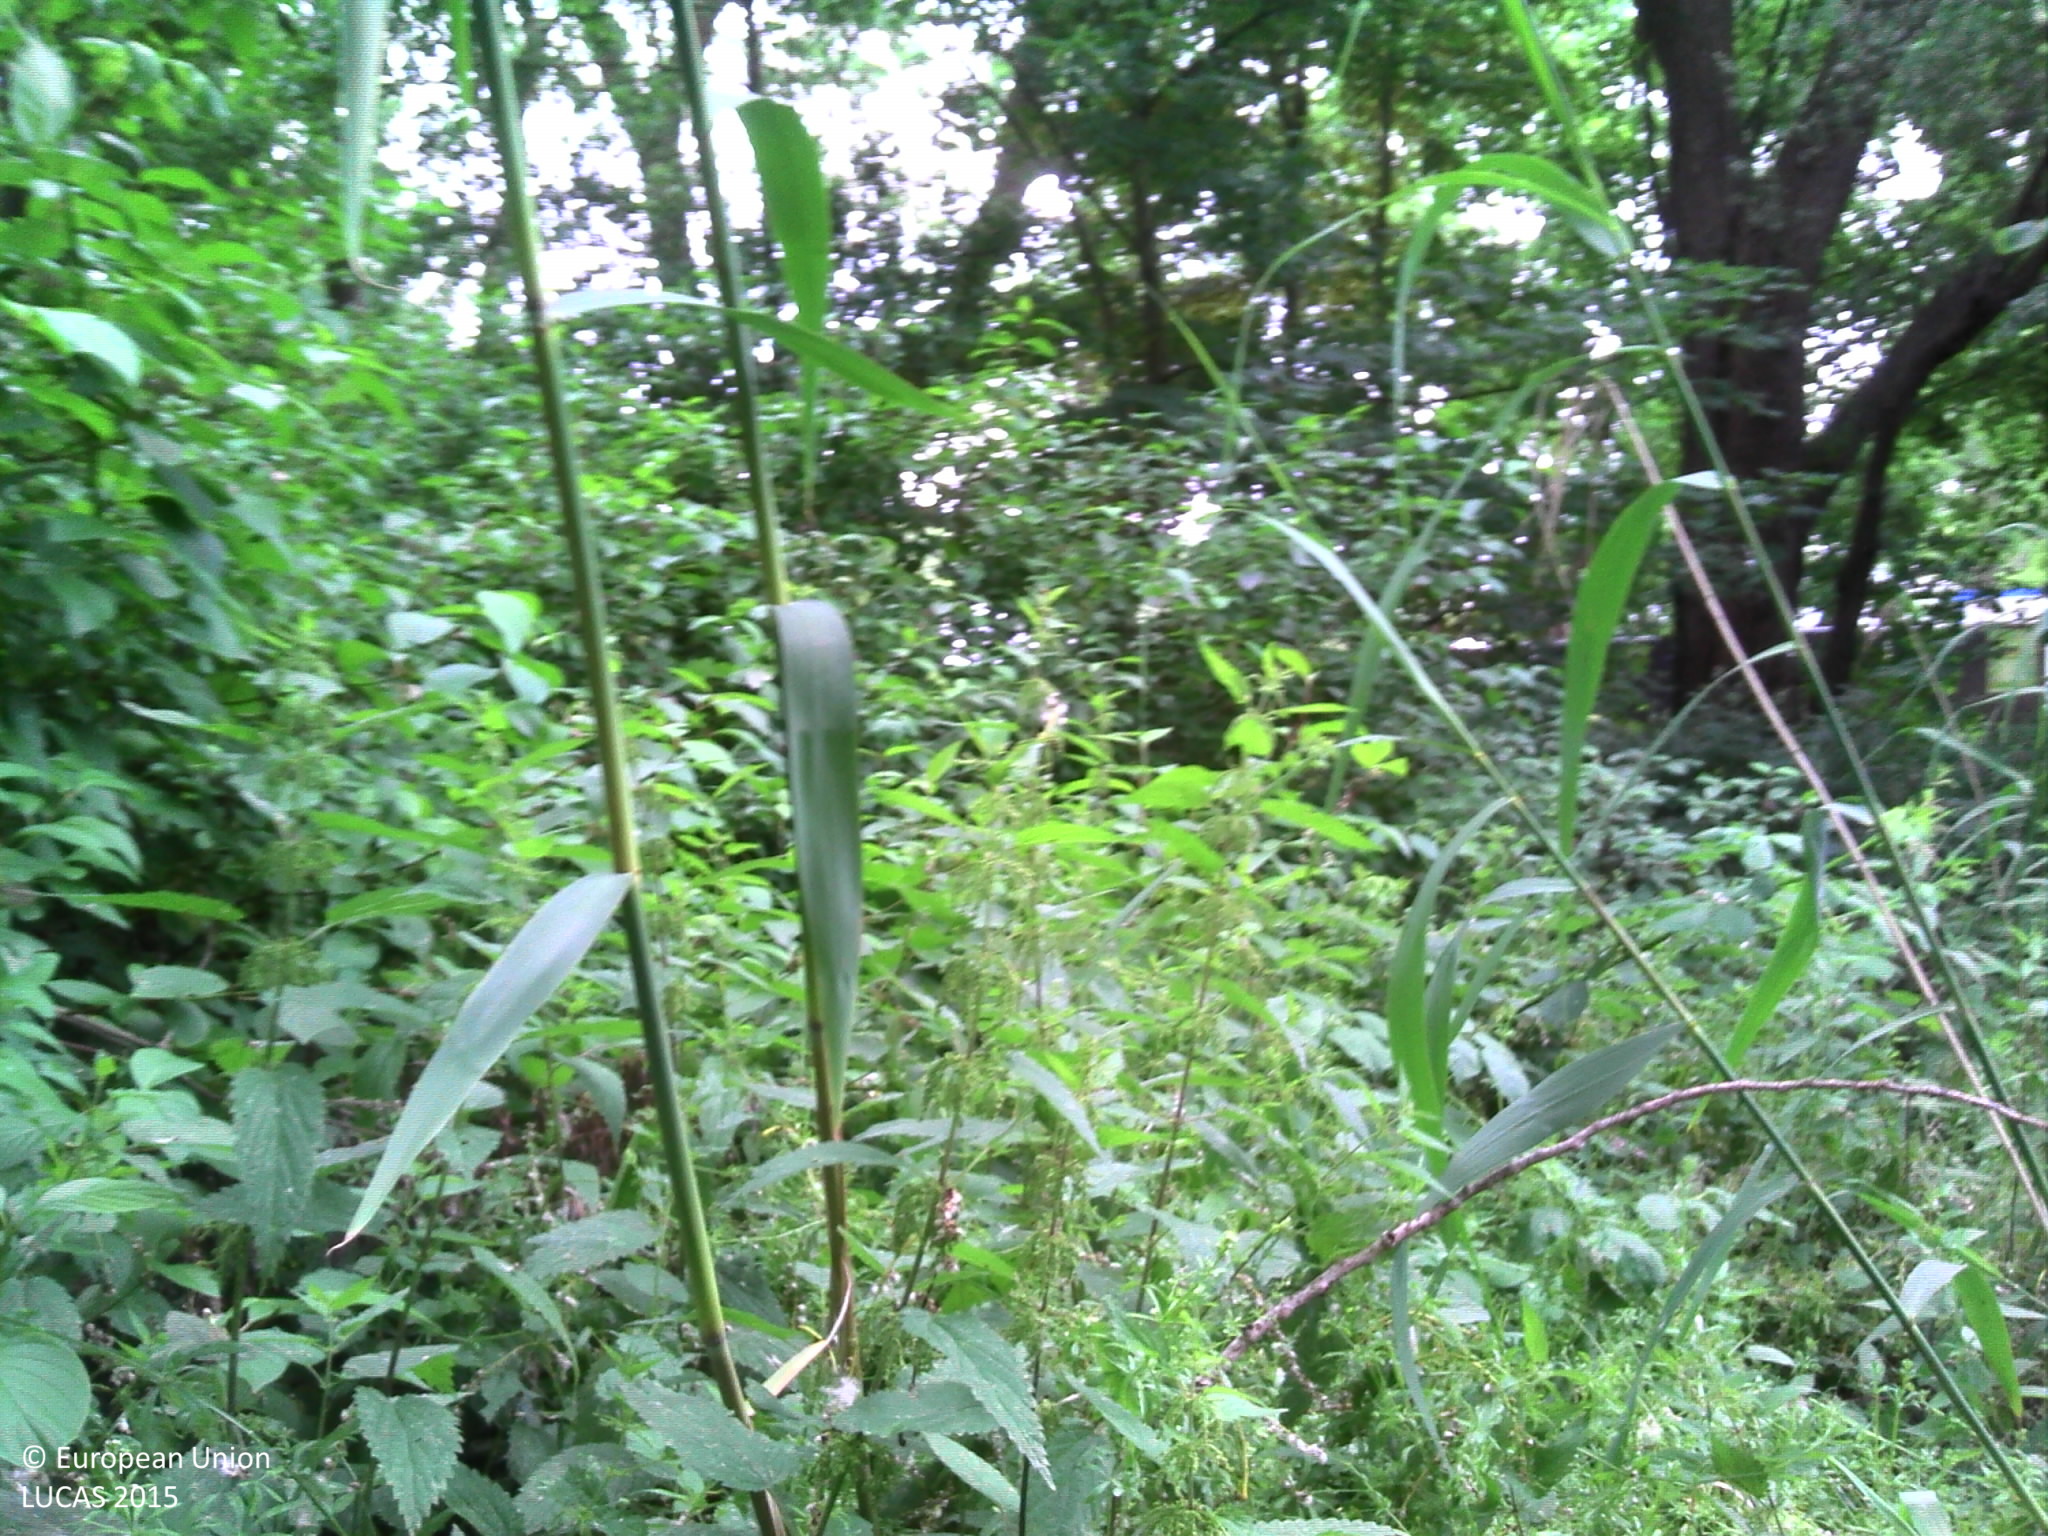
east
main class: Woodland
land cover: Broadleaved woodland
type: floodplain forest
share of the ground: > 75 %
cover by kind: broadleaved forest trees 100 %
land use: Forestry
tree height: > 5 m
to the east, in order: Broadleaved woodland; Tracks; Grassland without tree/shrub cover; Tracks; Grassland without tree/shrub cover; Inland fresh water bodies; Grassland with sparse tree/shrub cover; Tracks; Abandoned hedges; Fences; Ditches and canals; Grassland without tree/shrub cover; Artificial constructions in urban areas; Broadleaved woodland
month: June
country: BE
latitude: 51.0592
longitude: 3.7581
